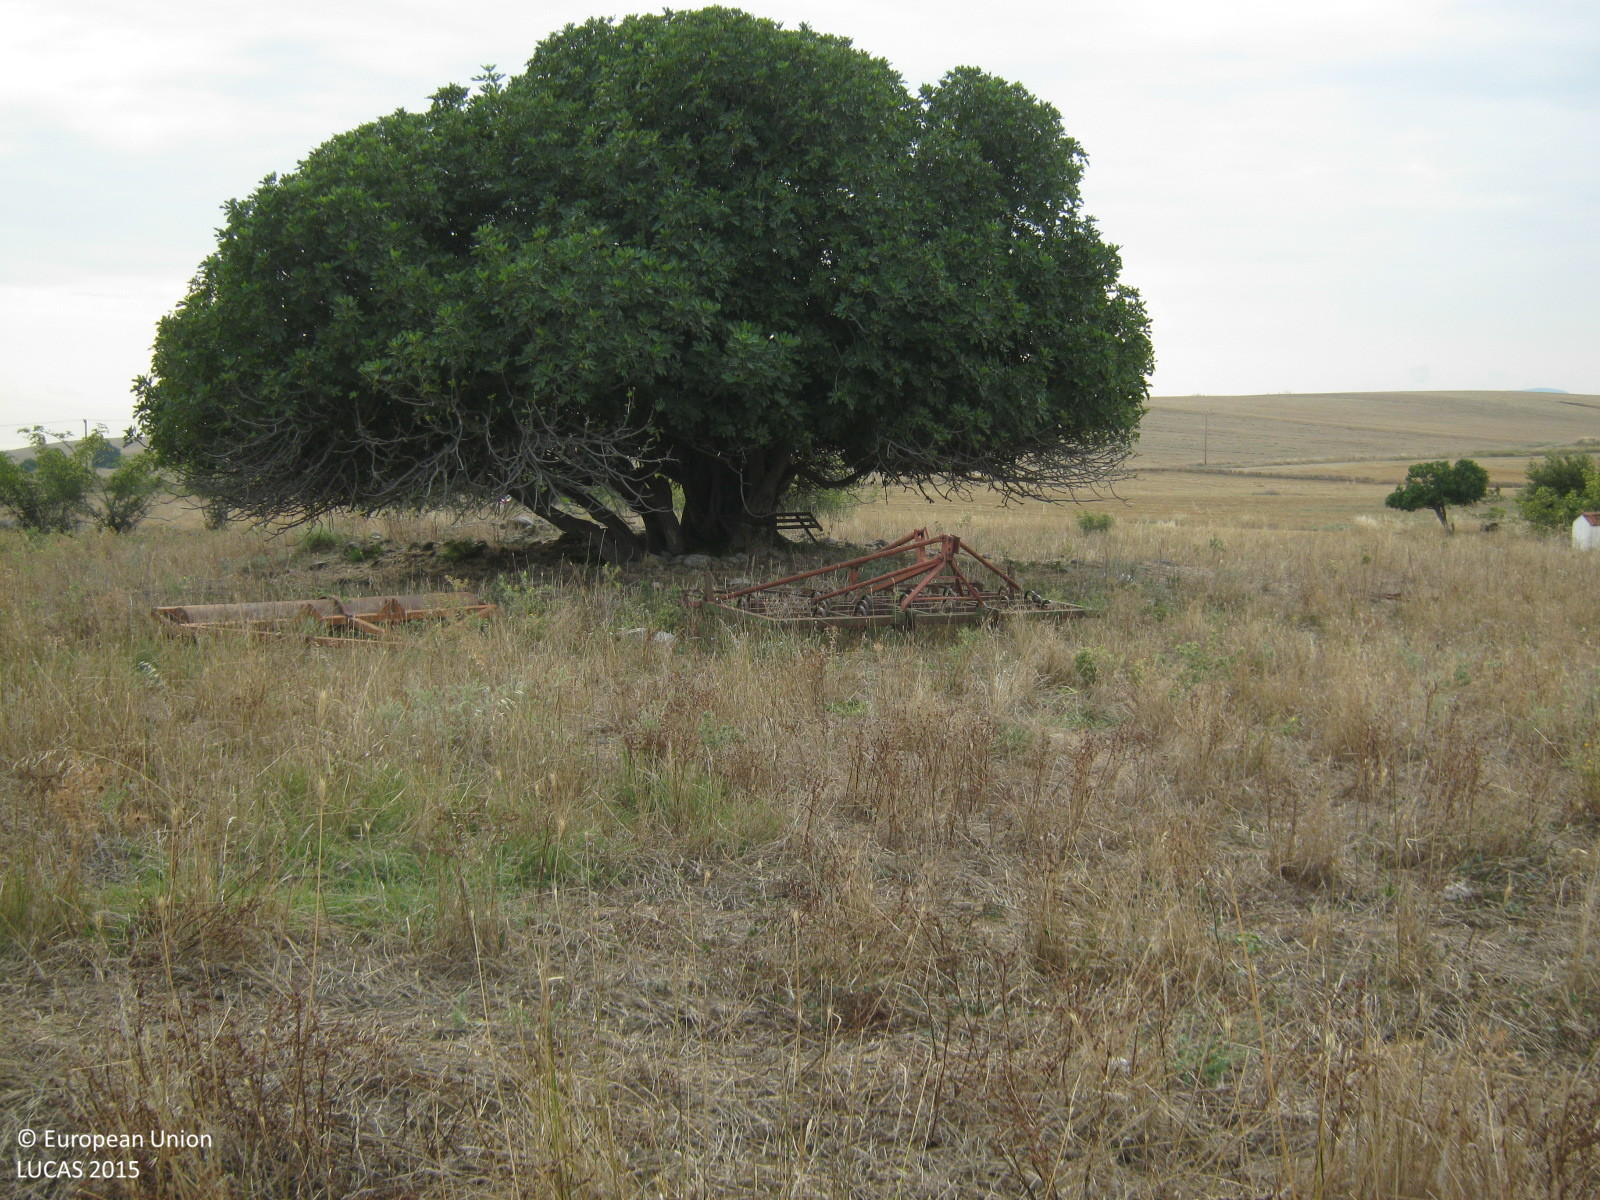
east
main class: Grassland
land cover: Grassland without tree/shrub cover
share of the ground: > 75 %
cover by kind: herbaceous plants 100 %
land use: Agriculture (excluding fallow land and kitchen gardens)
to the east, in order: Grassland without tree/shrub cover; Single bushes/trees; Grassland without tree/shrub cover; Abandoned hedges; Common wheat; Grass margins; Tracks; Abandoned hedges; Common wheat
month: July
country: GR
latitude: 39.1722
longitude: 22.6372
